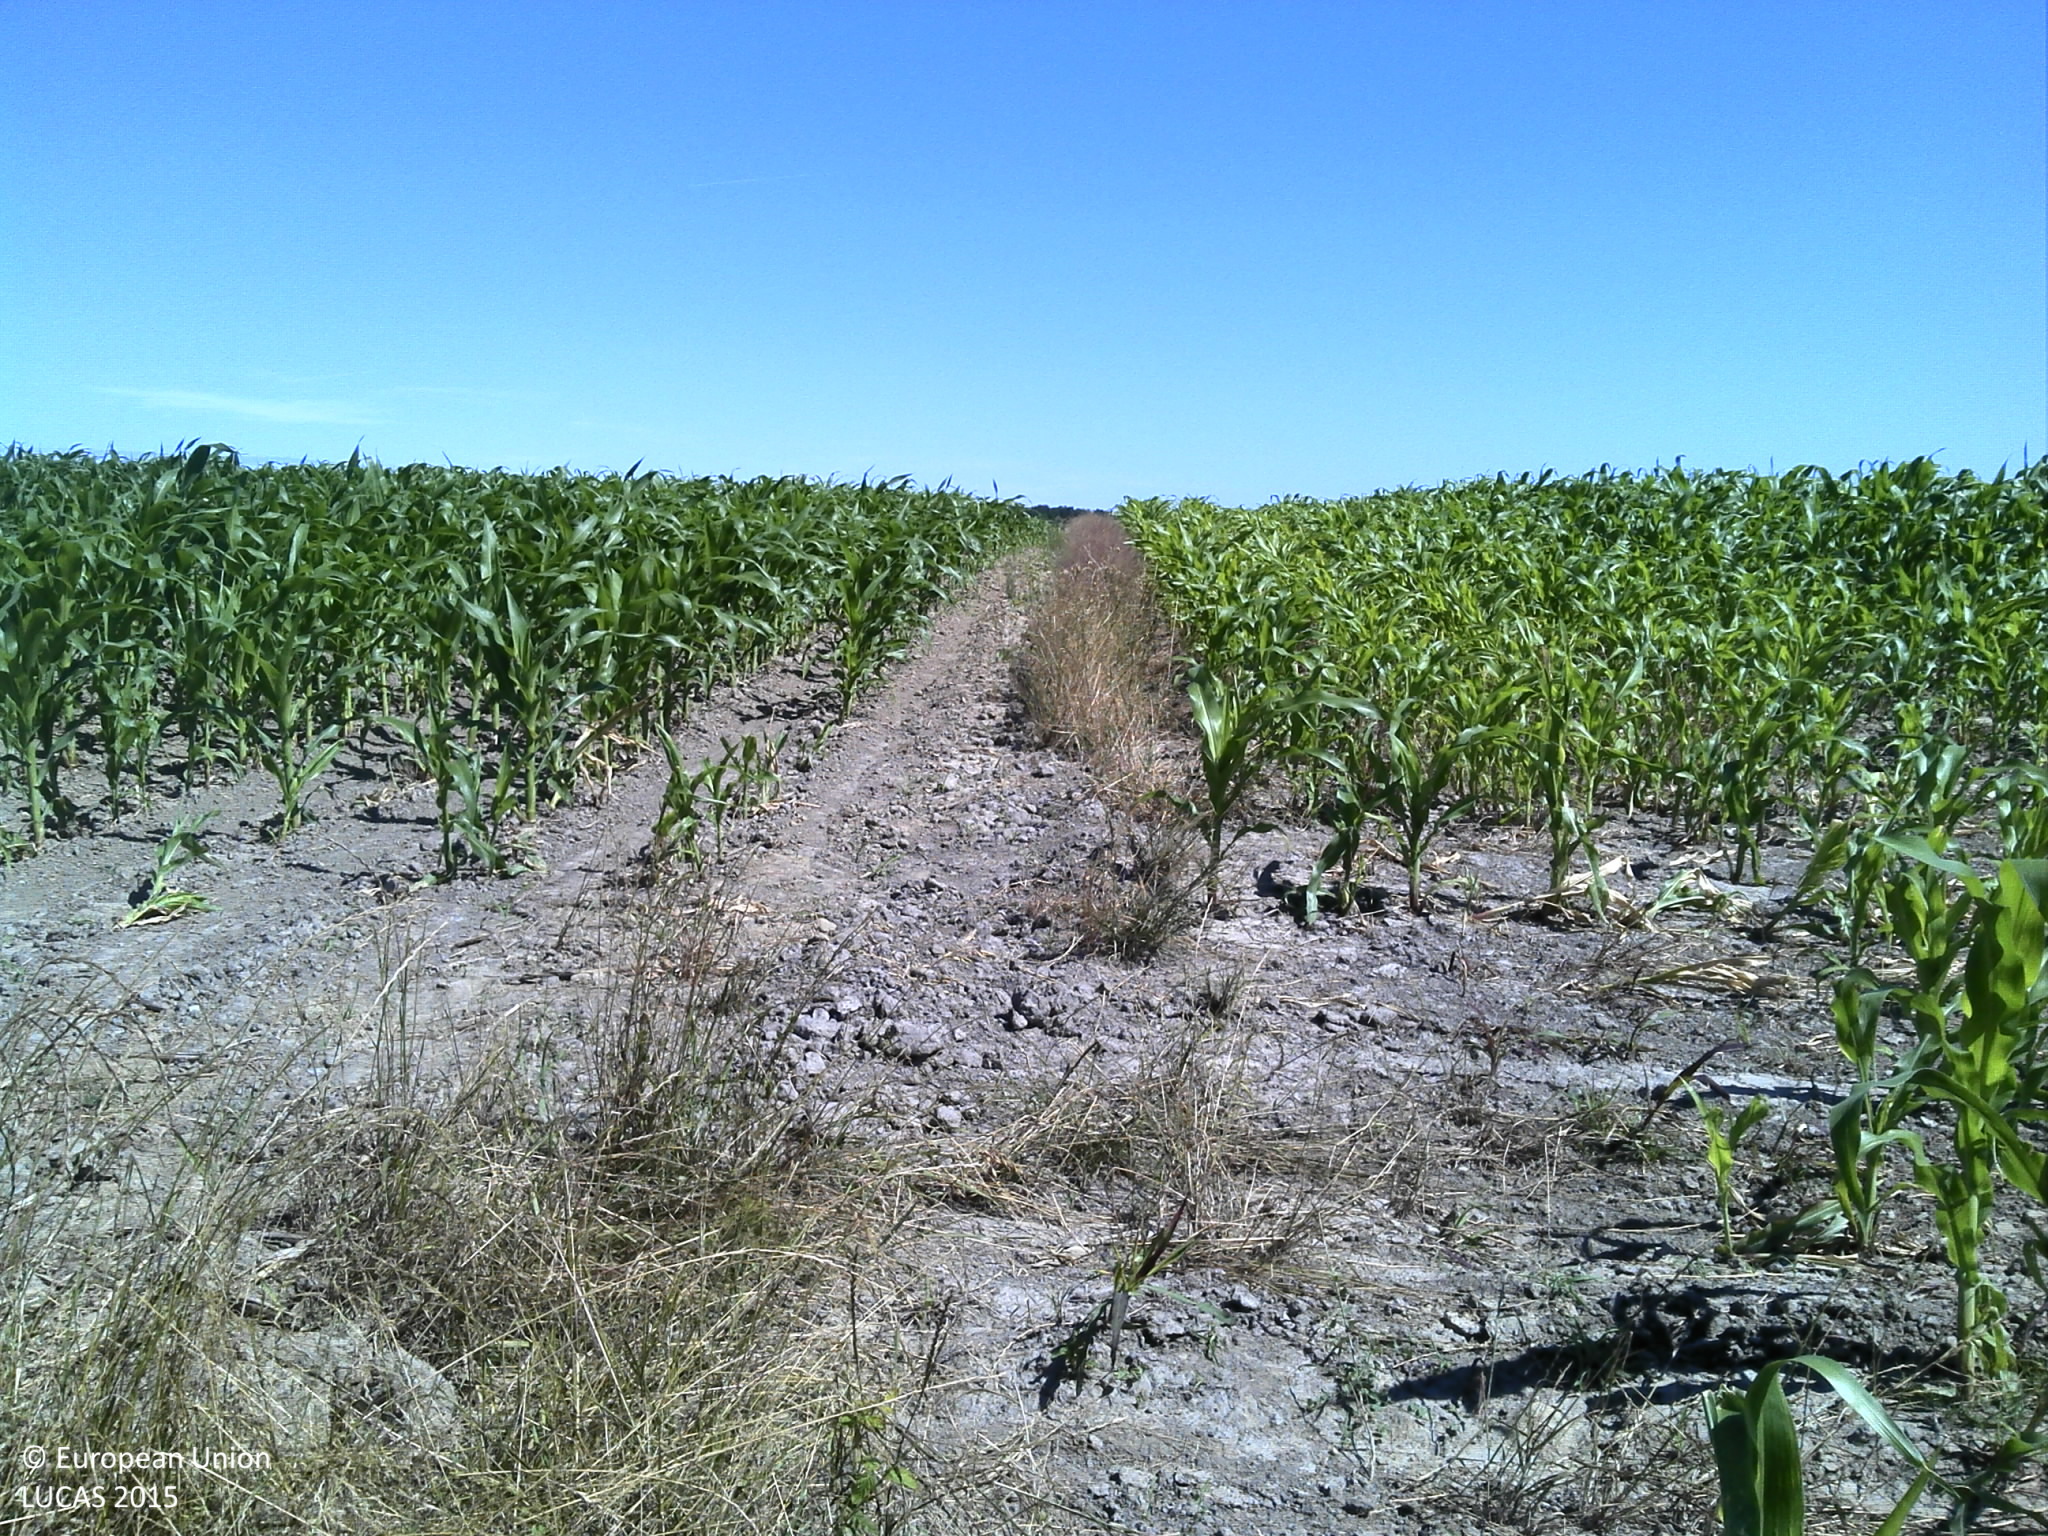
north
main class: Grassland
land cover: Grassland without tree/shrub cover
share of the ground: > 75 %
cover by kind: herbaceous plants 100 %
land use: Semi-natural and natural areas not in use
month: June
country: HR
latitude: 45.7465
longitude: 17.9610
